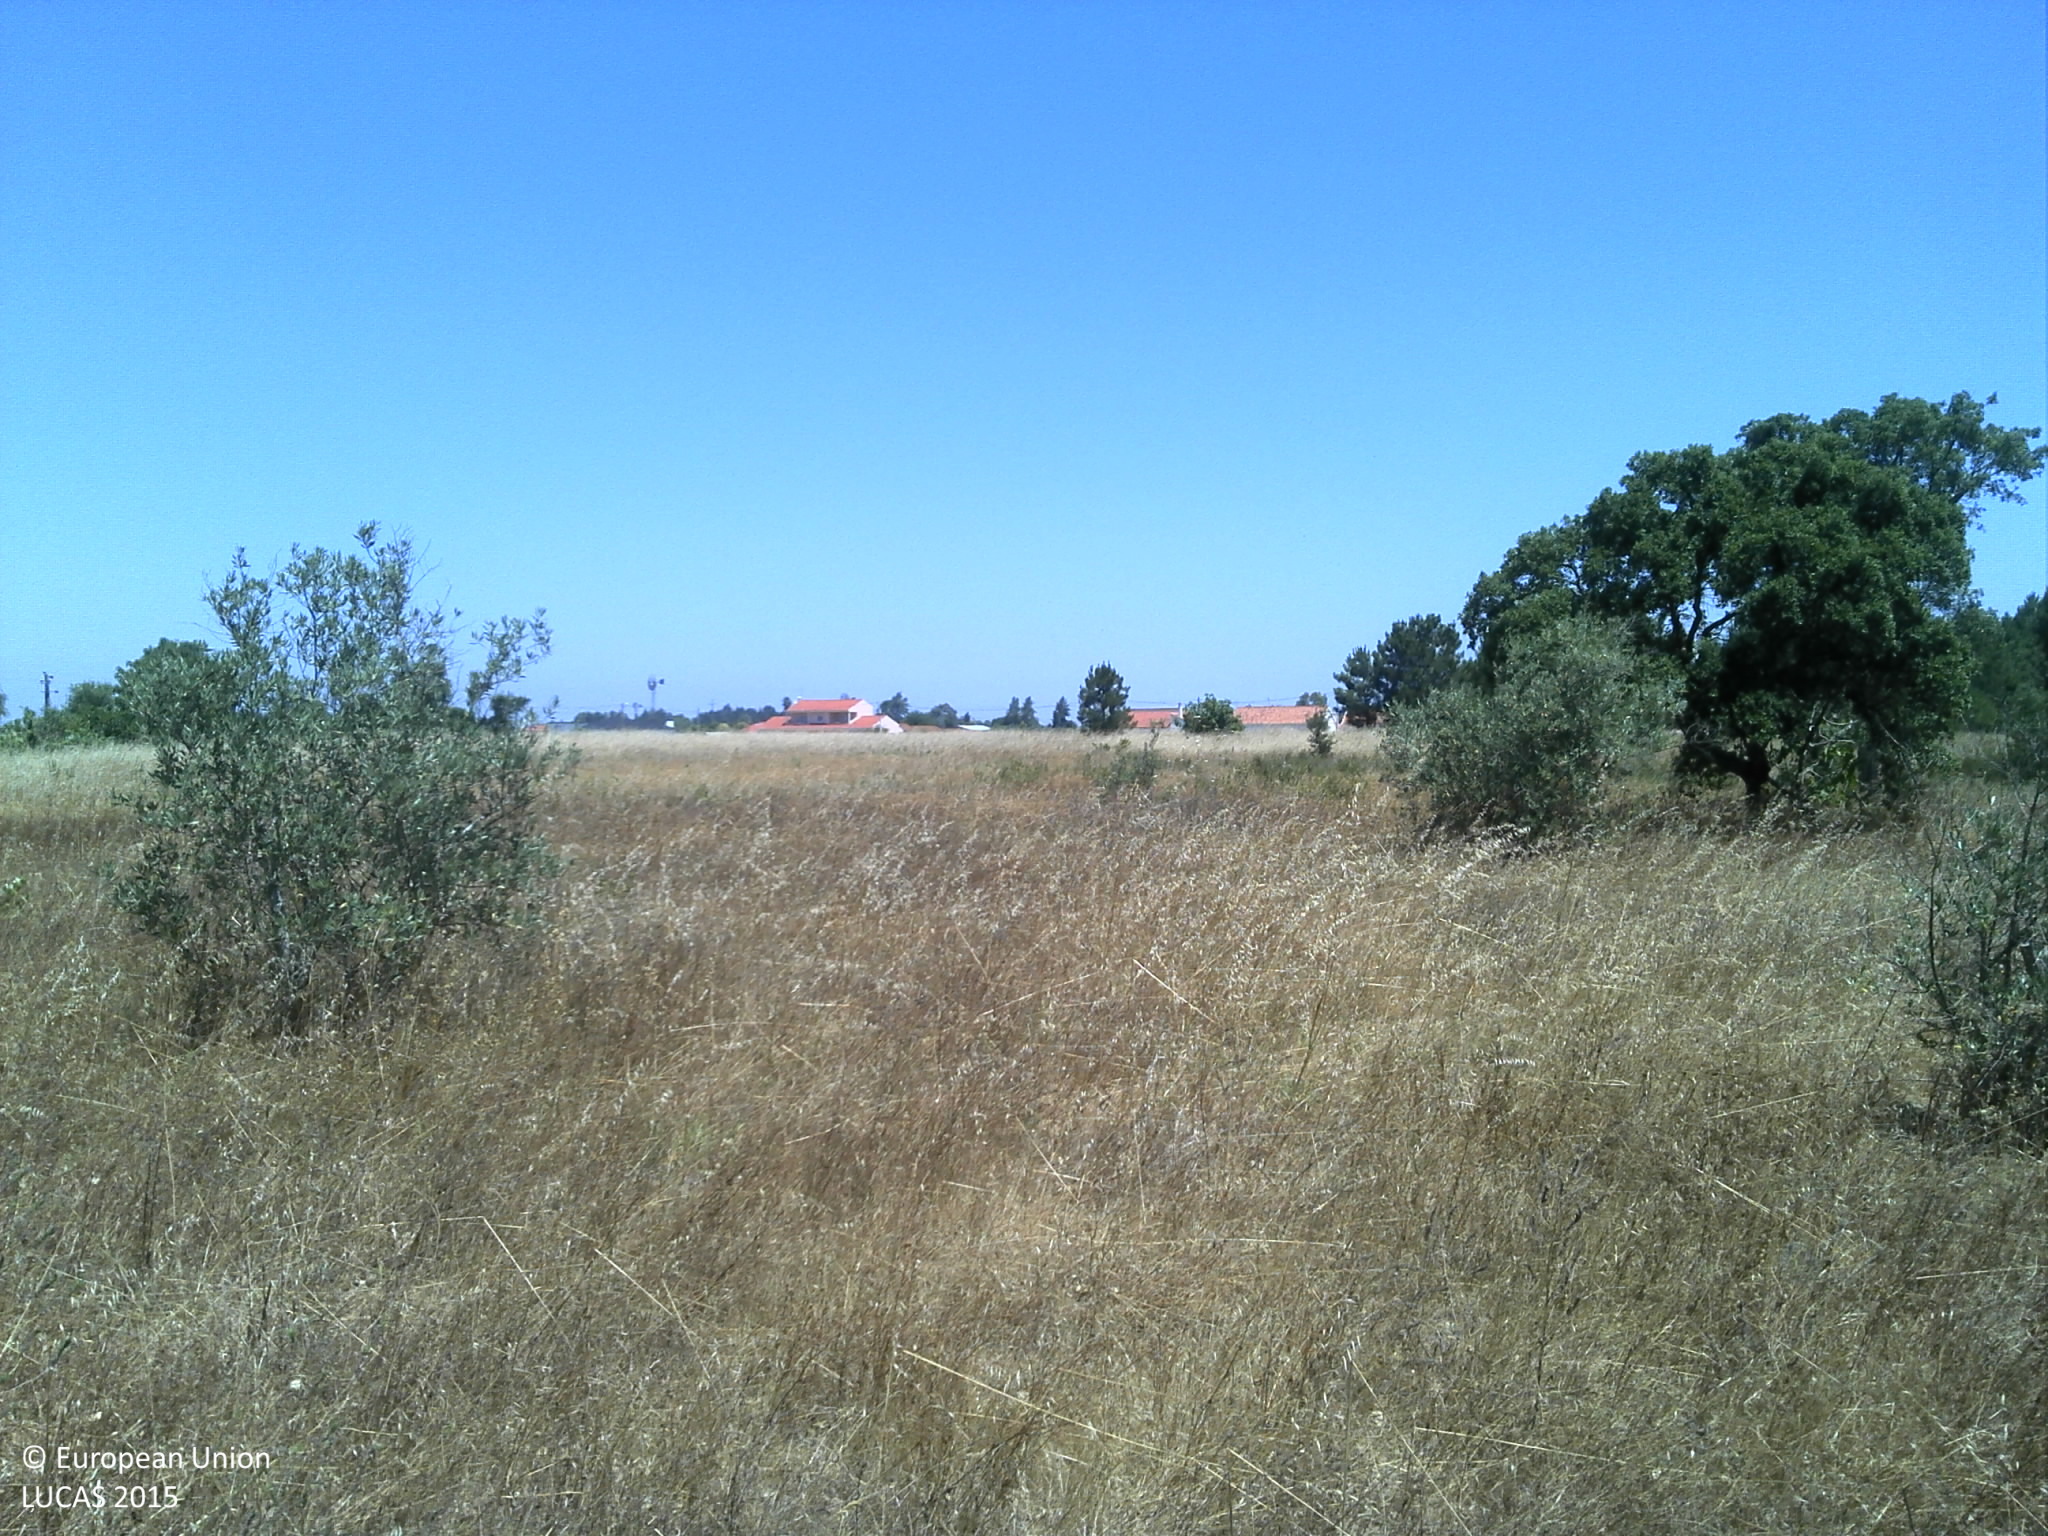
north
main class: Cropland
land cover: Olive groves
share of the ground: 25 - 50 %
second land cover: Grassland without tree/shrub cover
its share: 25 - 50 %
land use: Agriculture (excluding fallow land and kitchen gardens)
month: June
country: PT
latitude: 39.0733
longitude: -8.6430
